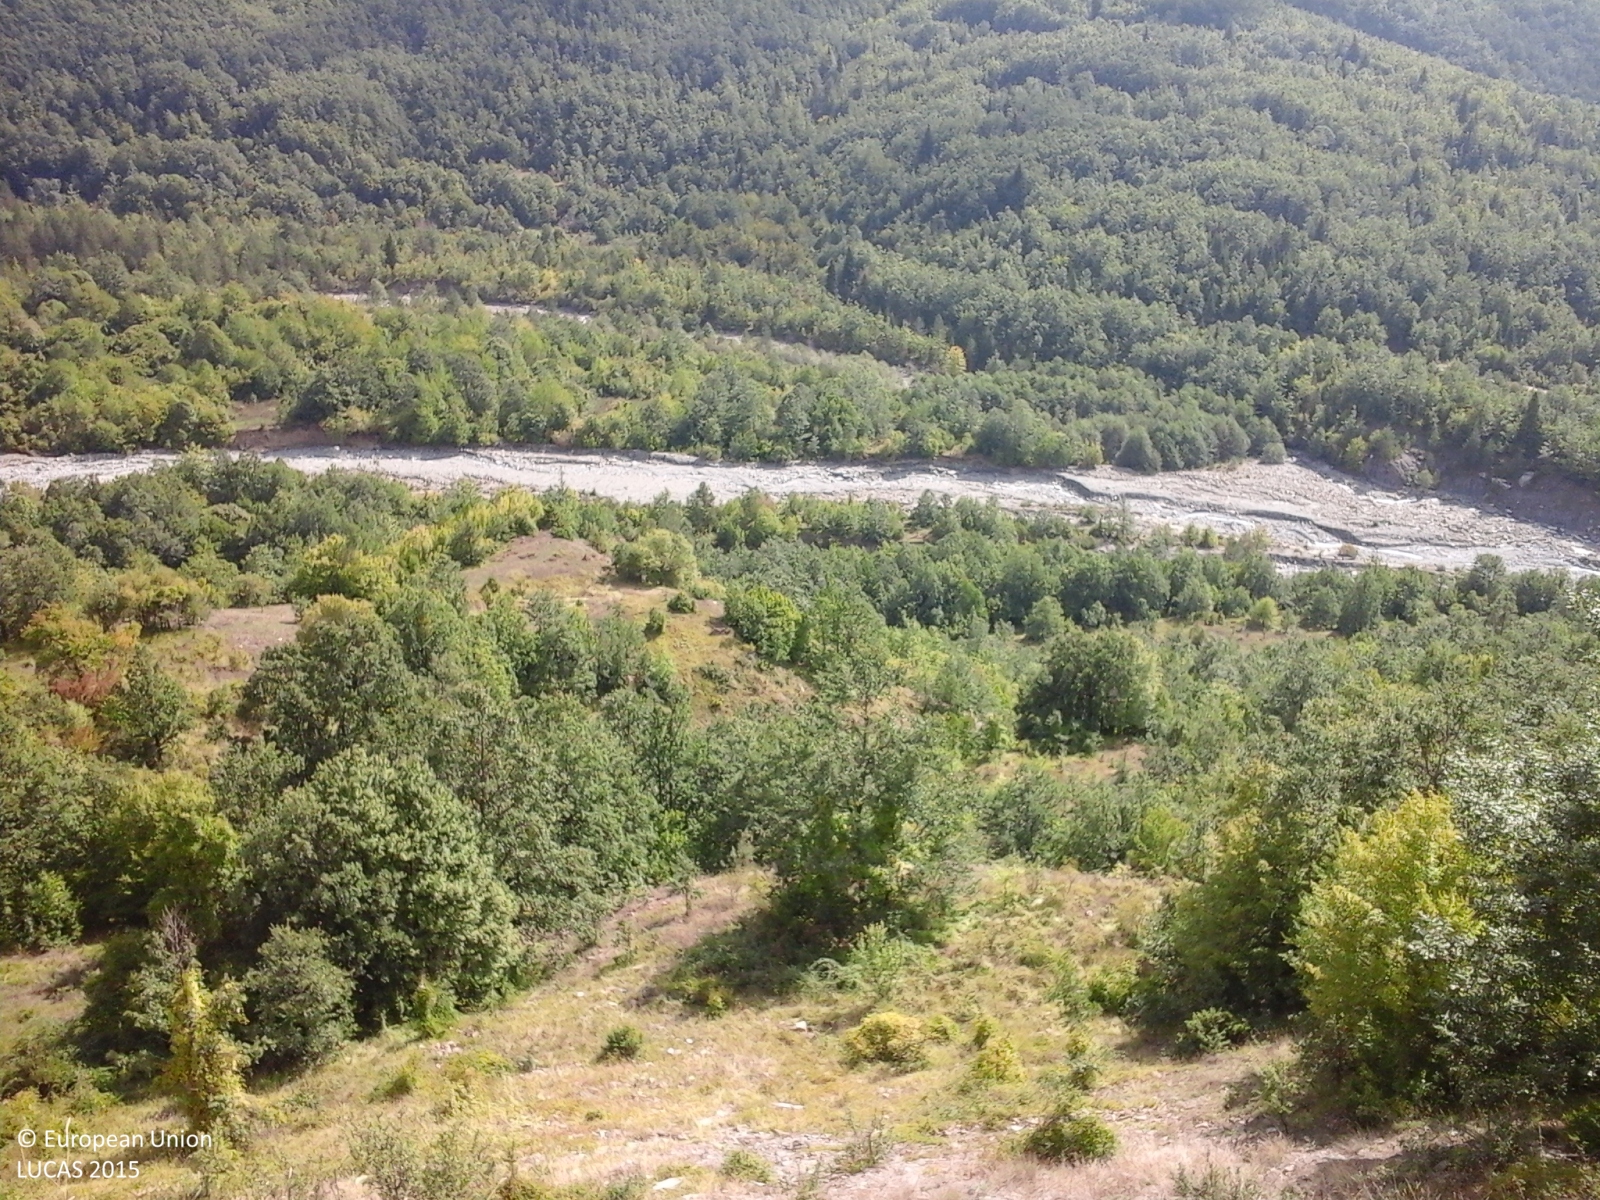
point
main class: Woodland
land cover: Broadleaved woodland
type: thermophilous deciduous forest
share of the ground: > 75 %
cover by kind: broadleaved forest trees 80 %, herbaceous plants 15 %, shrubs 5 %
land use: Semi-natural and natural areas not in use
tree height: > 5 m
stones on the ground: 10 - 25 %
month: October
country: GR
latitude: 40.2925
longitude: 20.7716
